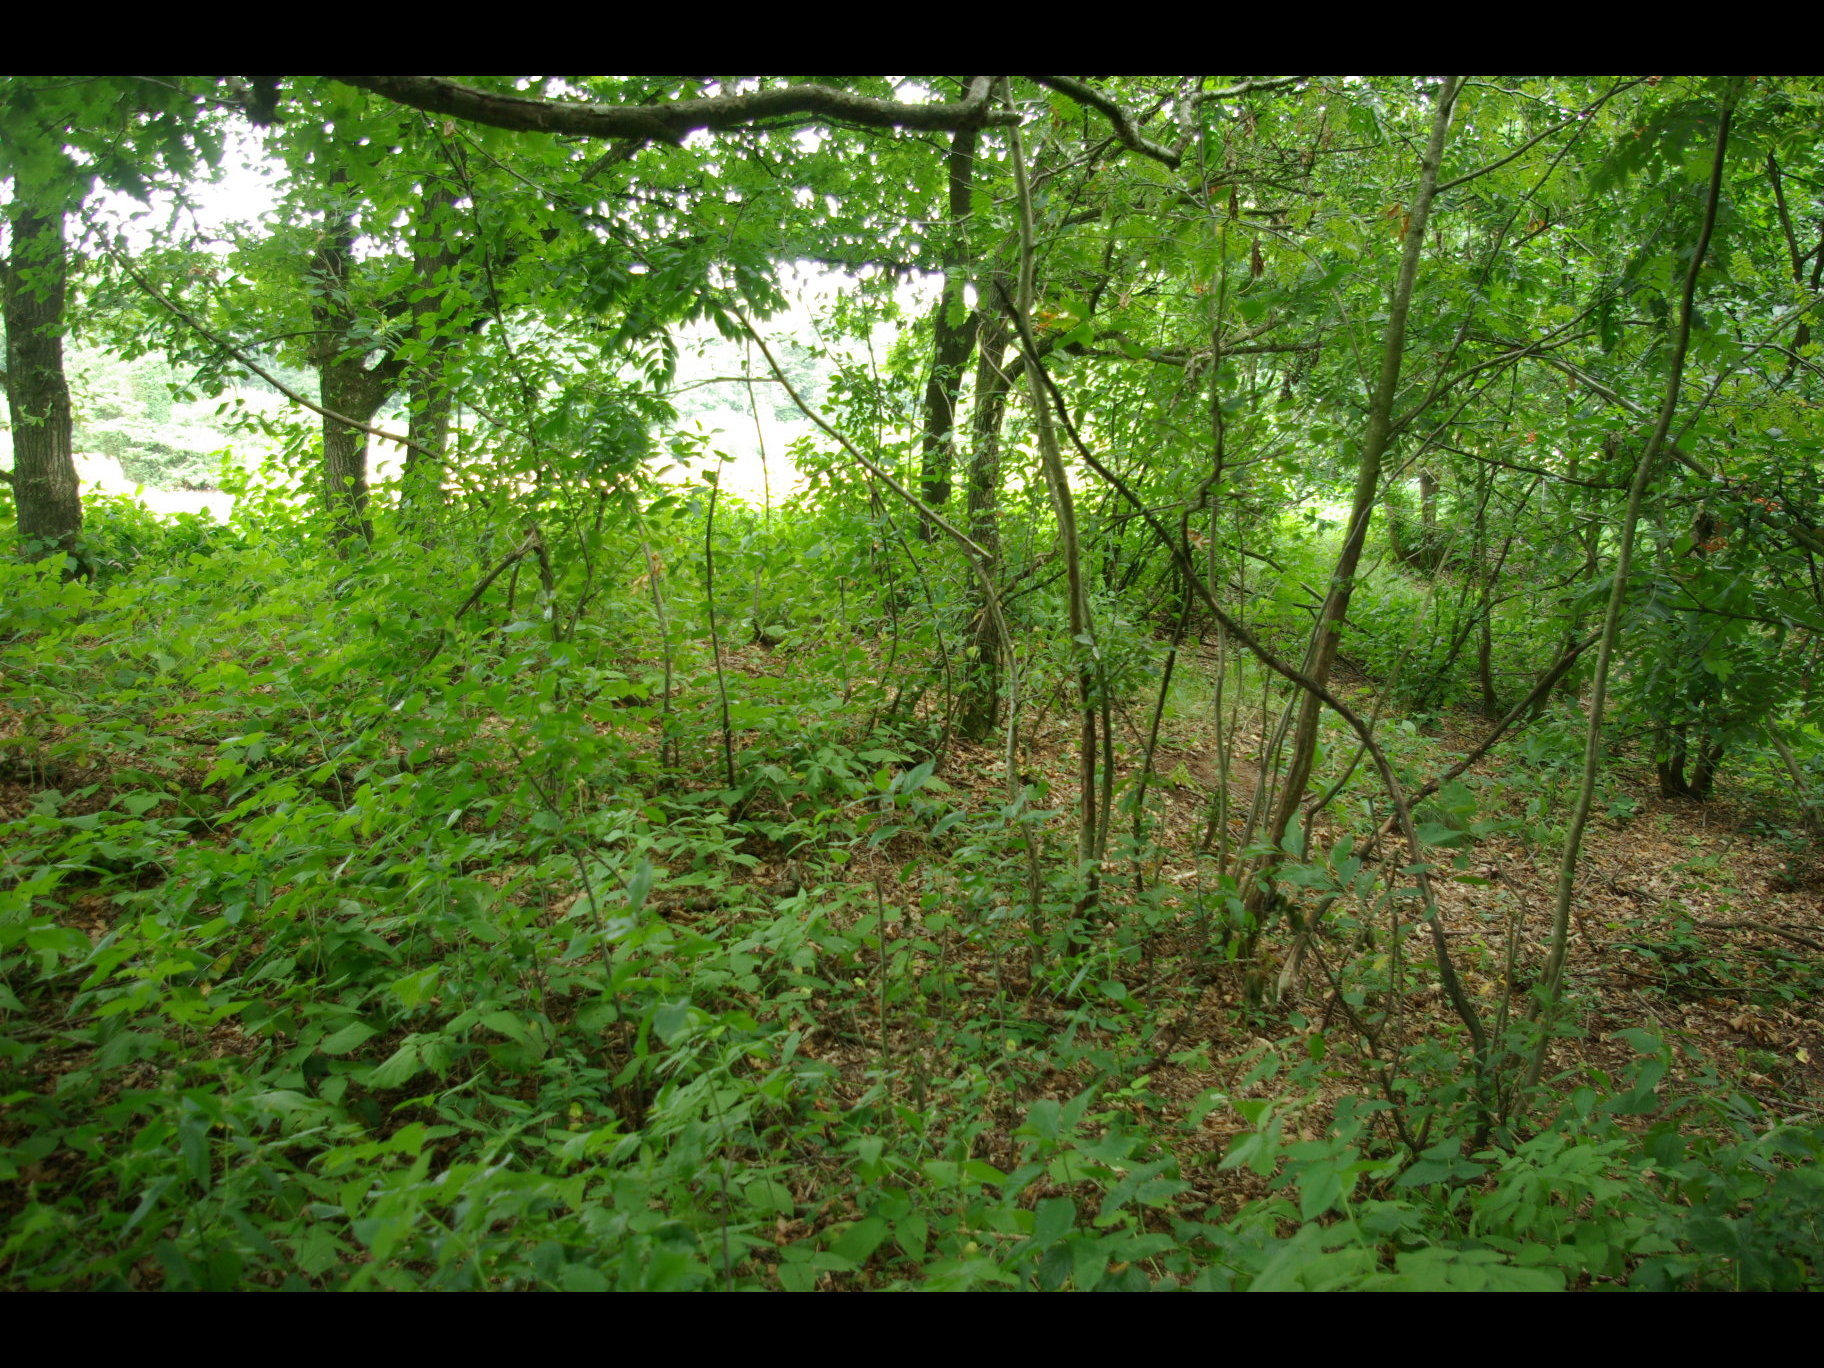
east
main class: Woodland
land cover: Broadleaved woodland
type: mesophytic deciduous forest
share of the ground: > 75 %
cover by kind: broadleaved forest trees 80 %, shrubs 10 %, herbaceous plants 10 %
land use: Semi-natural and natural areas not in use
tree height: > 5 m
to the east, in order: Broadleaved woodland; Spontaneously vegetated surfaces; Grassland without tree/shrub cover; Shrubland without tree cover; Grassland without tree/shrub cover; Shrubland without tree cover; Grassland without tree/shrub cover; Spontaneously vegetated surfaces; Fences; Broadleaved woodland; Ditches and canals; Broadleaved woodland
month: August
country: DE
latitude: 54.6219
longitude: 9.2726
